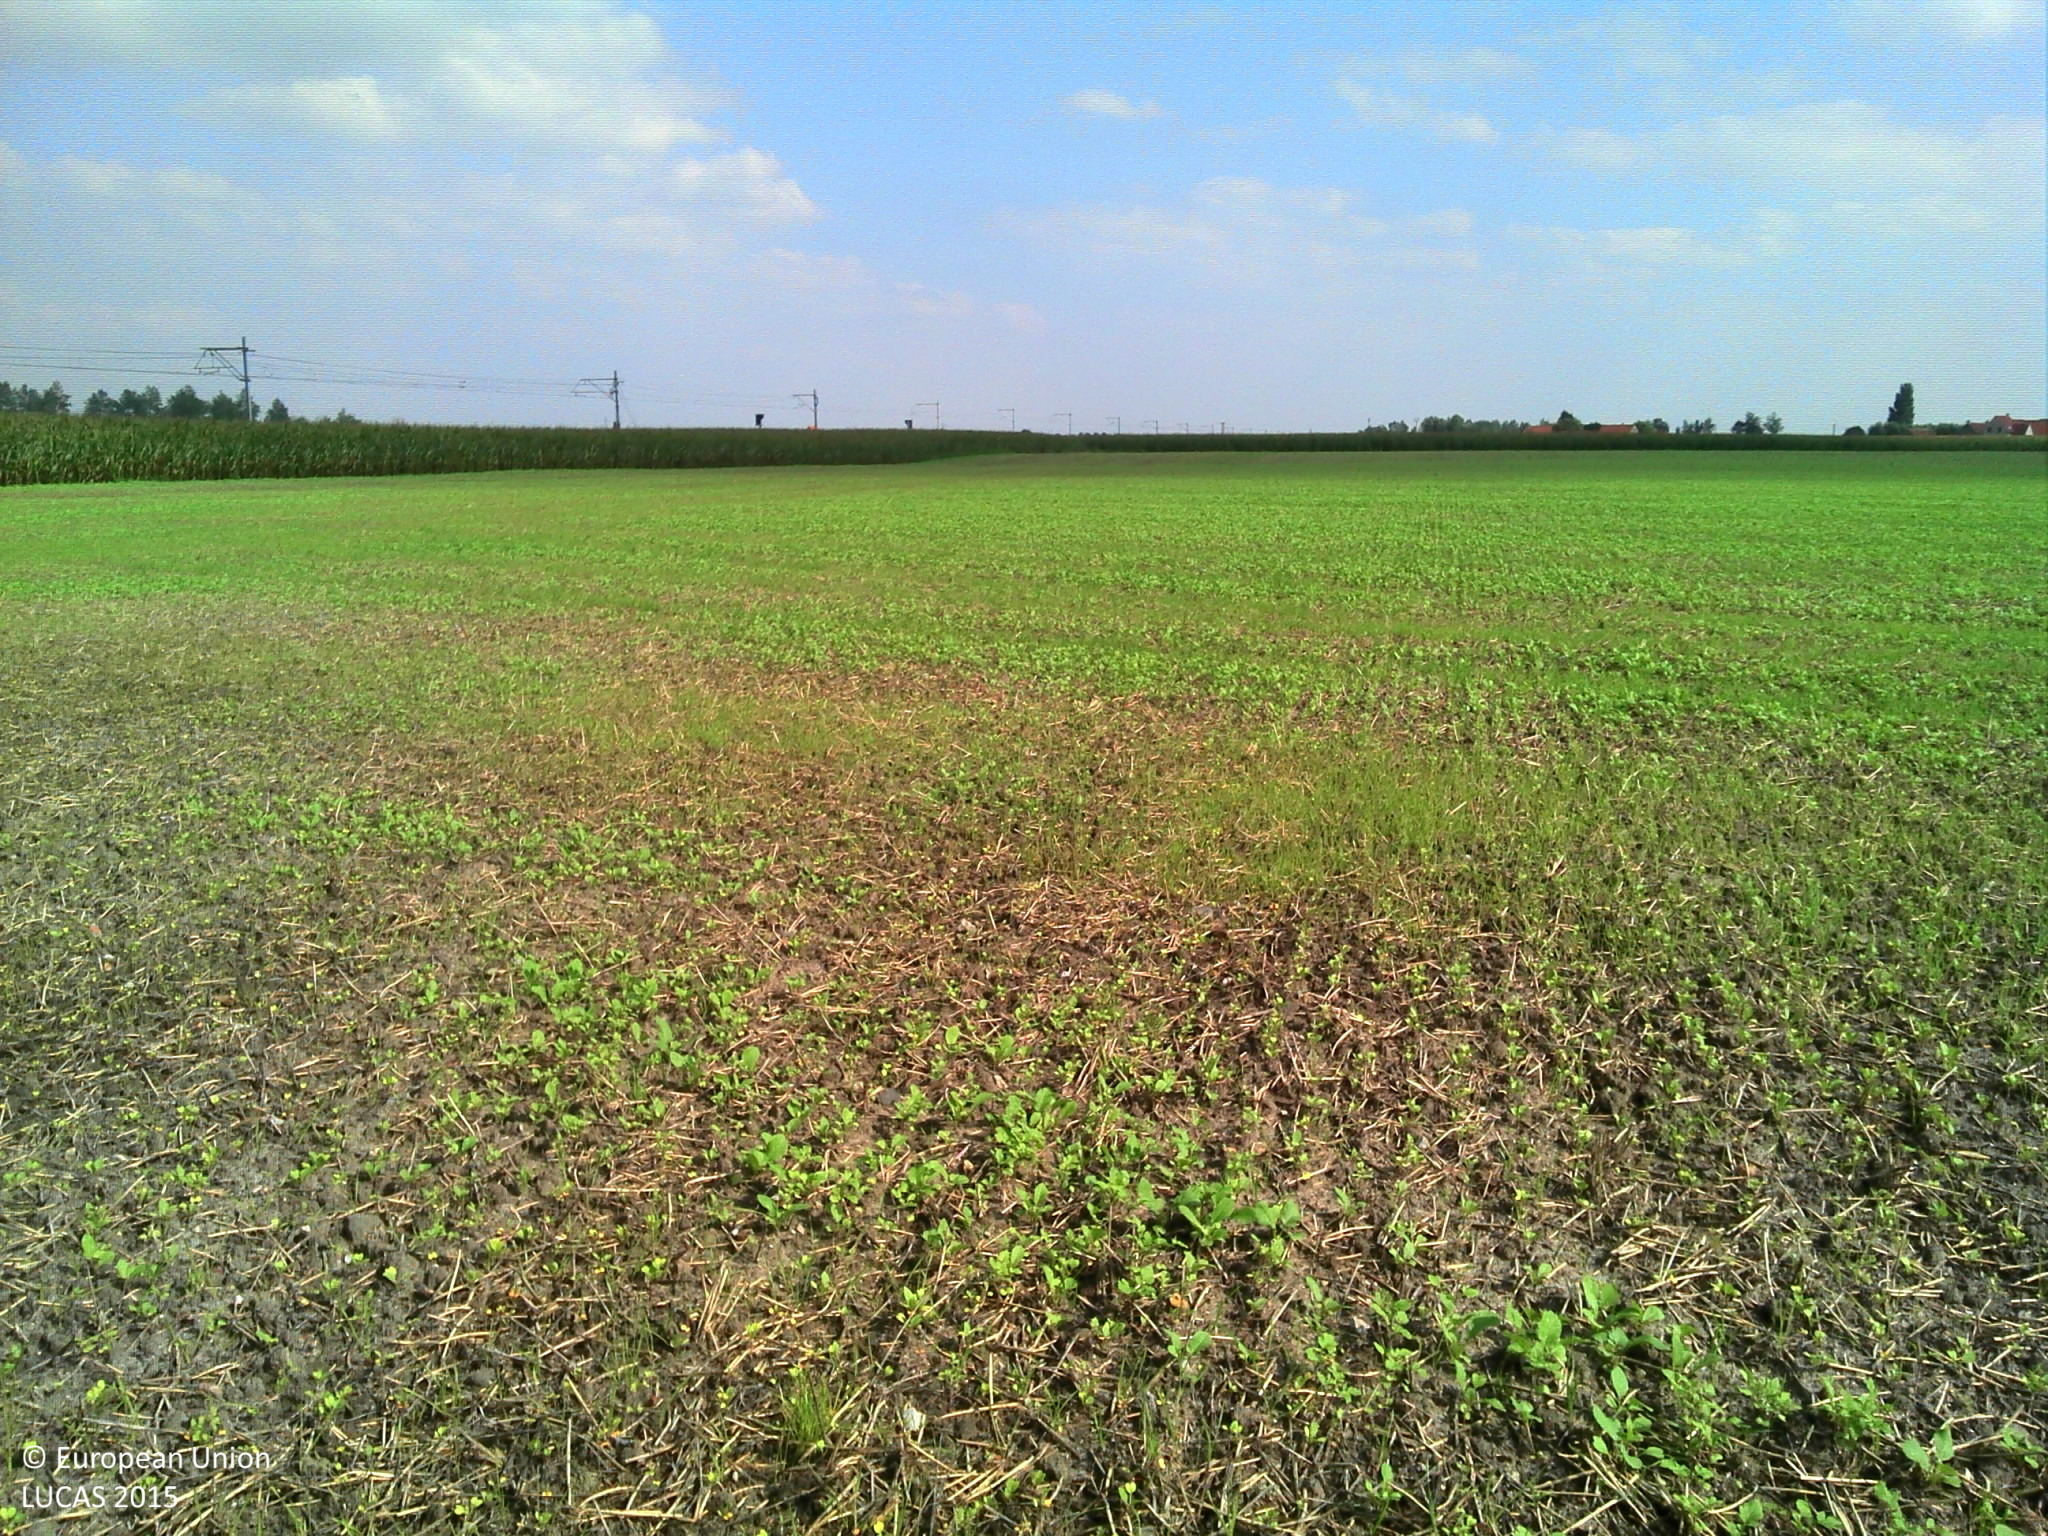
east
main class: Cropland
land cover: Common wheat
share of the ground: 25 - 50 %
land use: Agriculture (excluding fallow land and kitchen gardens)
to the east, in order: Common wheat; Maize
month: September
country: BE
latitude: 51.0692
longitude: 2.6958
